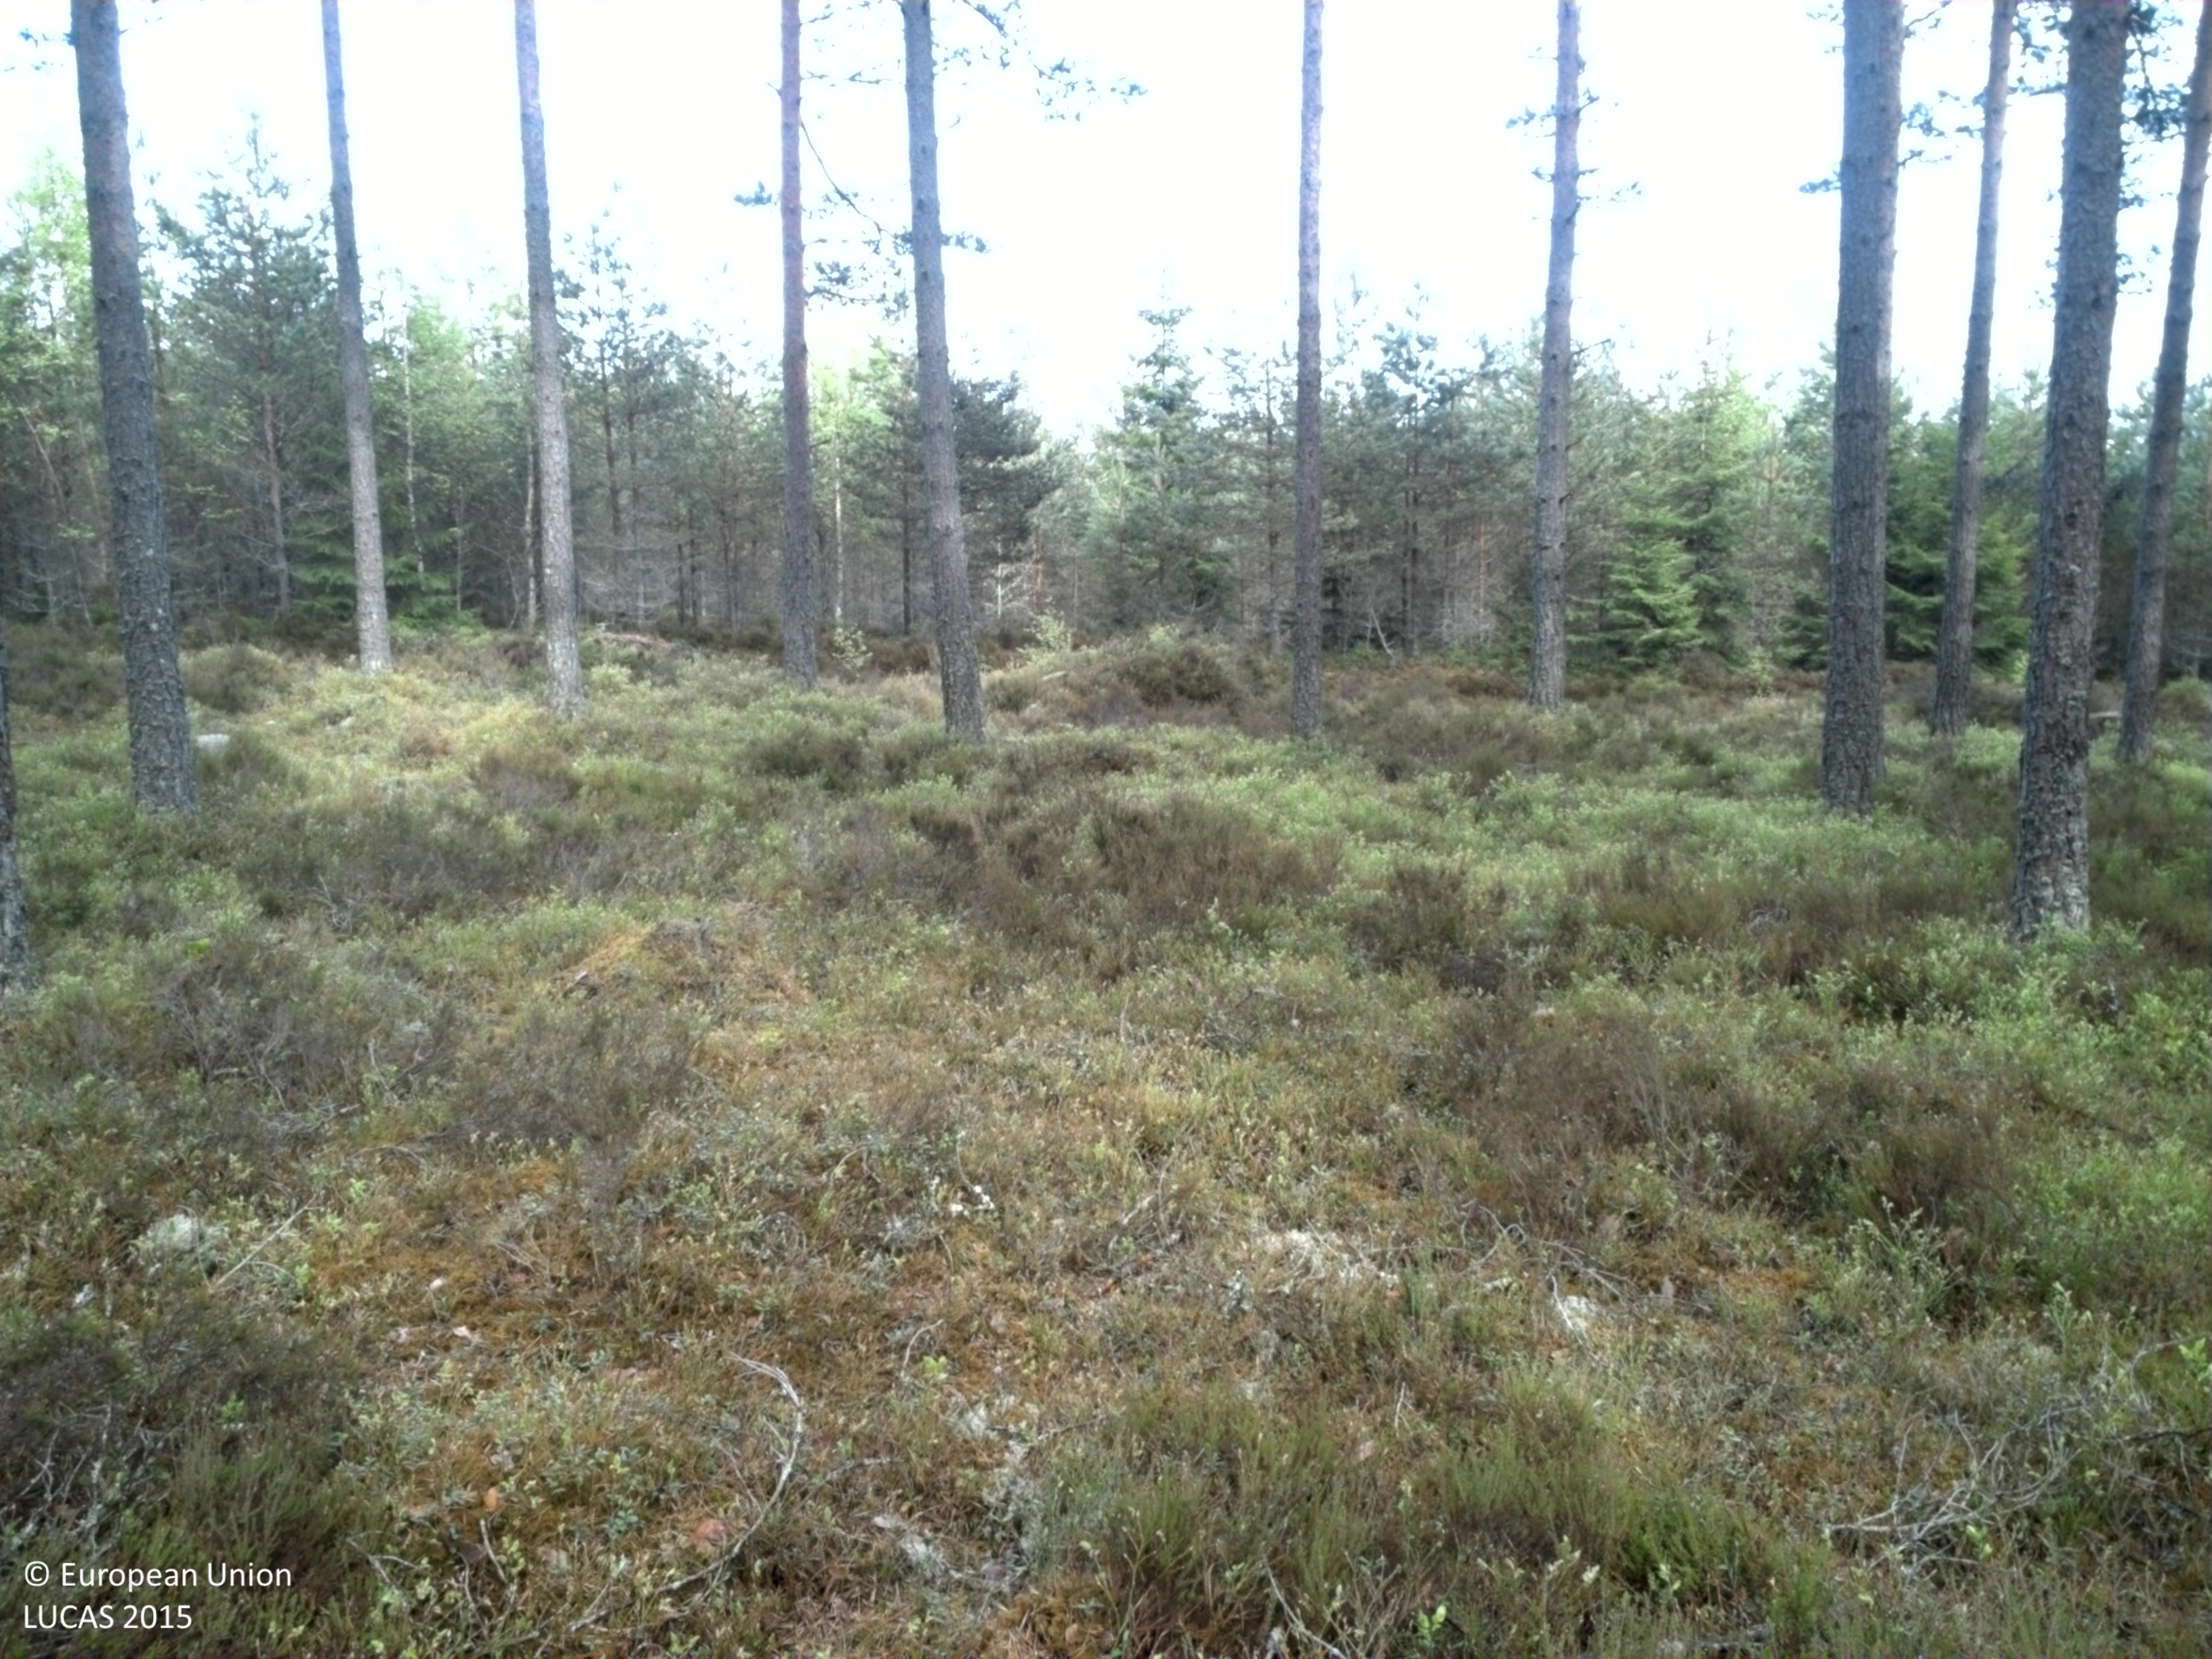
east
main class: Woodland
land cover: Pine dominated coniferous woodland
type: boreal forest
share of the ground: 50 - 75 %
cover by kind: coniferous forest trees 50 %, shrubs 40 %, herbaceous plants 5 %, lichens and mosses 5 %
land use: Forestry
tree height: > 5 m
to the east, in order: Pine dominated coniferous woodland; Paved roads, cycling and walking lanes; Pine dominated coniferous woodland; Other coniferous woodland
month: May
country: SE
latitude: 59.1583
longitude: 14.3464
